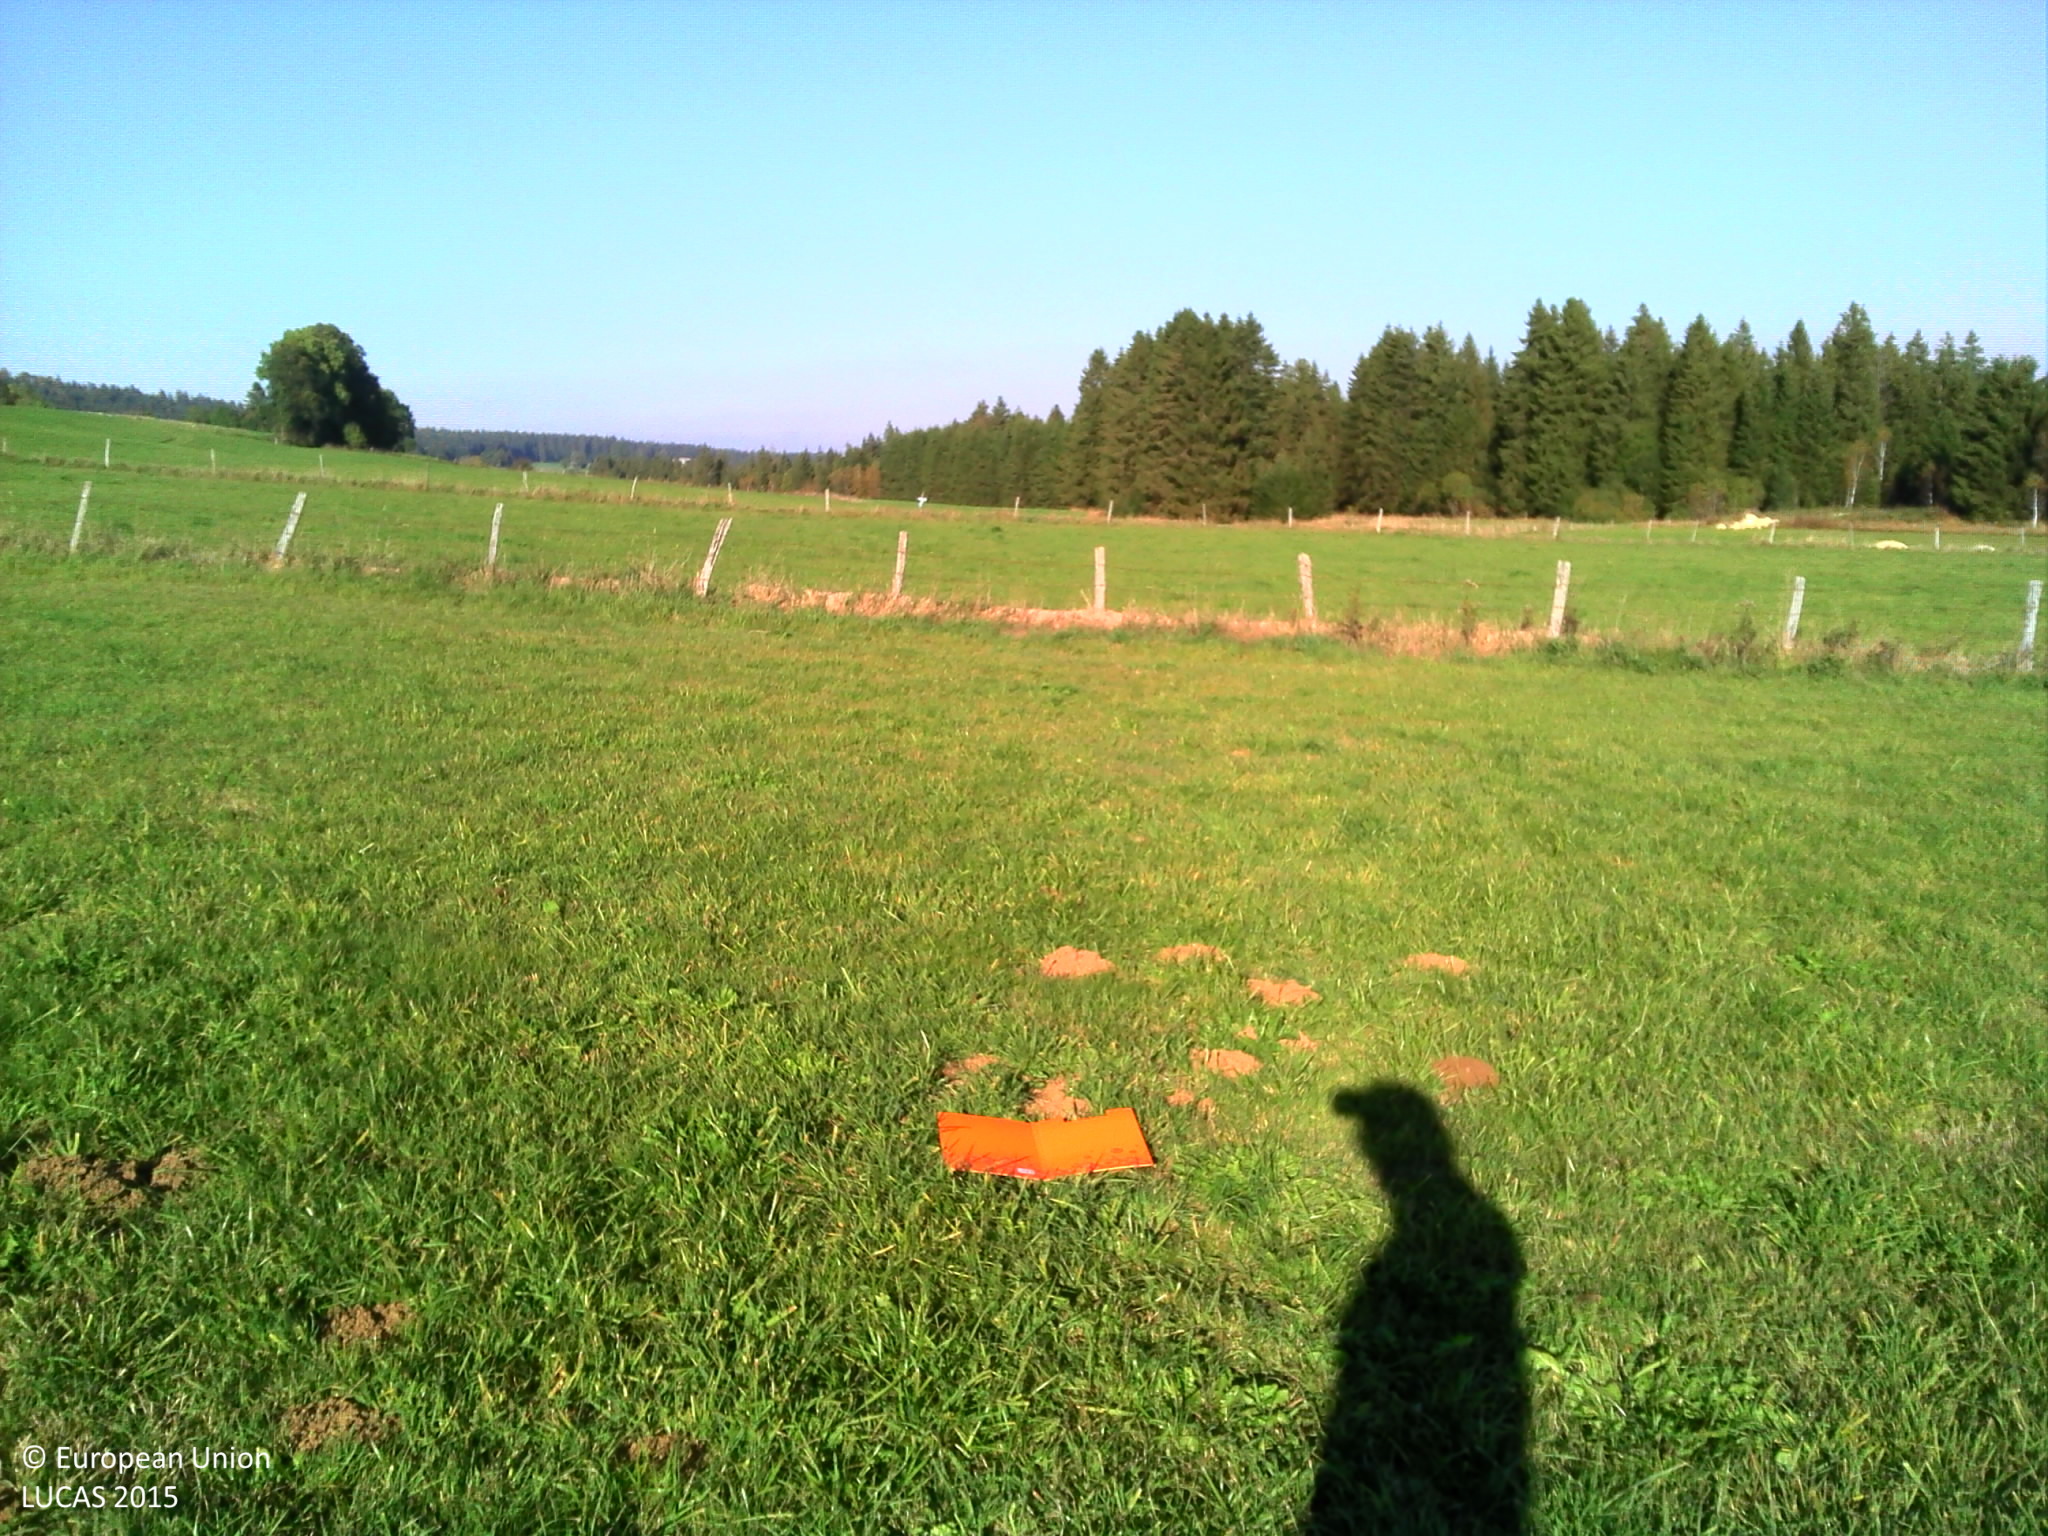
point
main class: Grassland
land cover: Grassland without tree/shrub cover
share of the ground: > 75 %
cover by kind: herbaceous plants 100 %
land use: Agriculture (excluding fallow land and kitchen gardens)
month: September
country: FR
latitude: 47.1096
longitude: 6.6418
